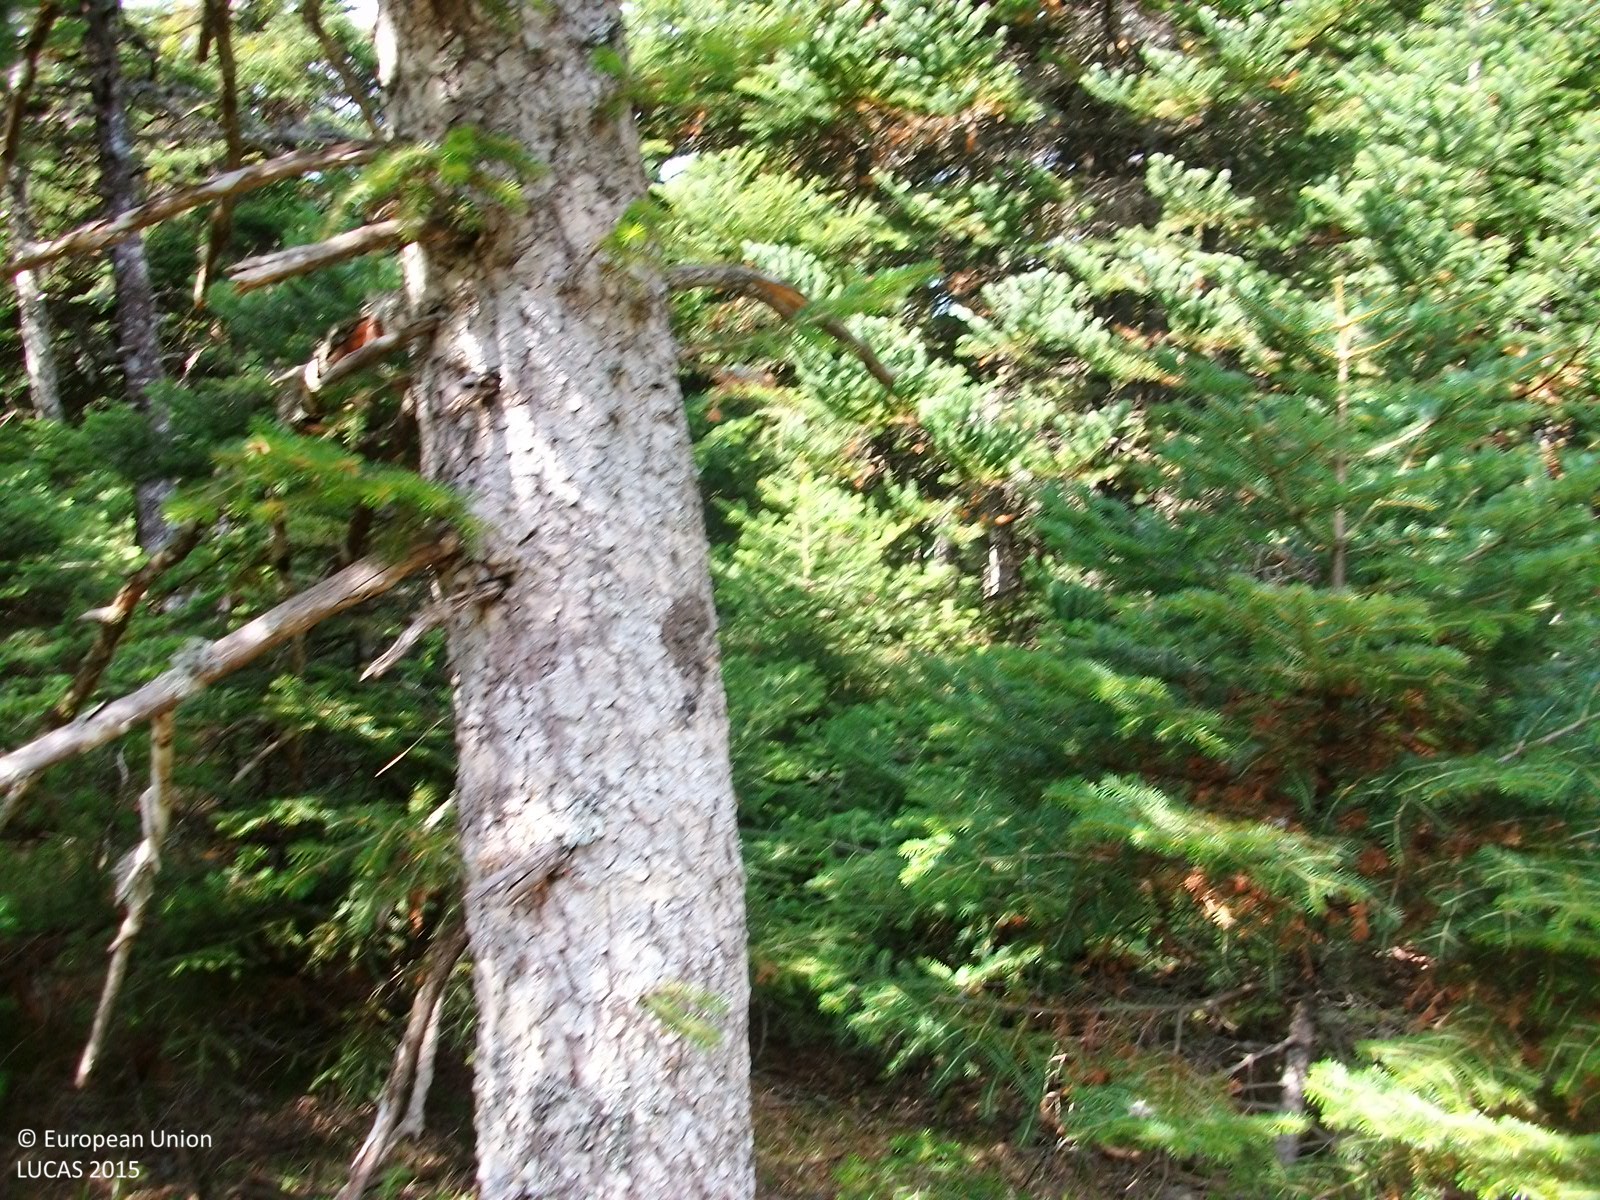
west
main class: Woodland
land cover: Spruce dominated coniferous woodland
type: coniferous forest of the mediterranean region
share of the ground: > 75 %
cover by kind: coniferous forest trees 85 %, unconsolidated bare surface 15 %
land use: Forestry
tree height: > 5 m
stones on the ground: 10 - 25 %
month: September
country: GR
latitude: 38.1771
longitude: 23.7392
